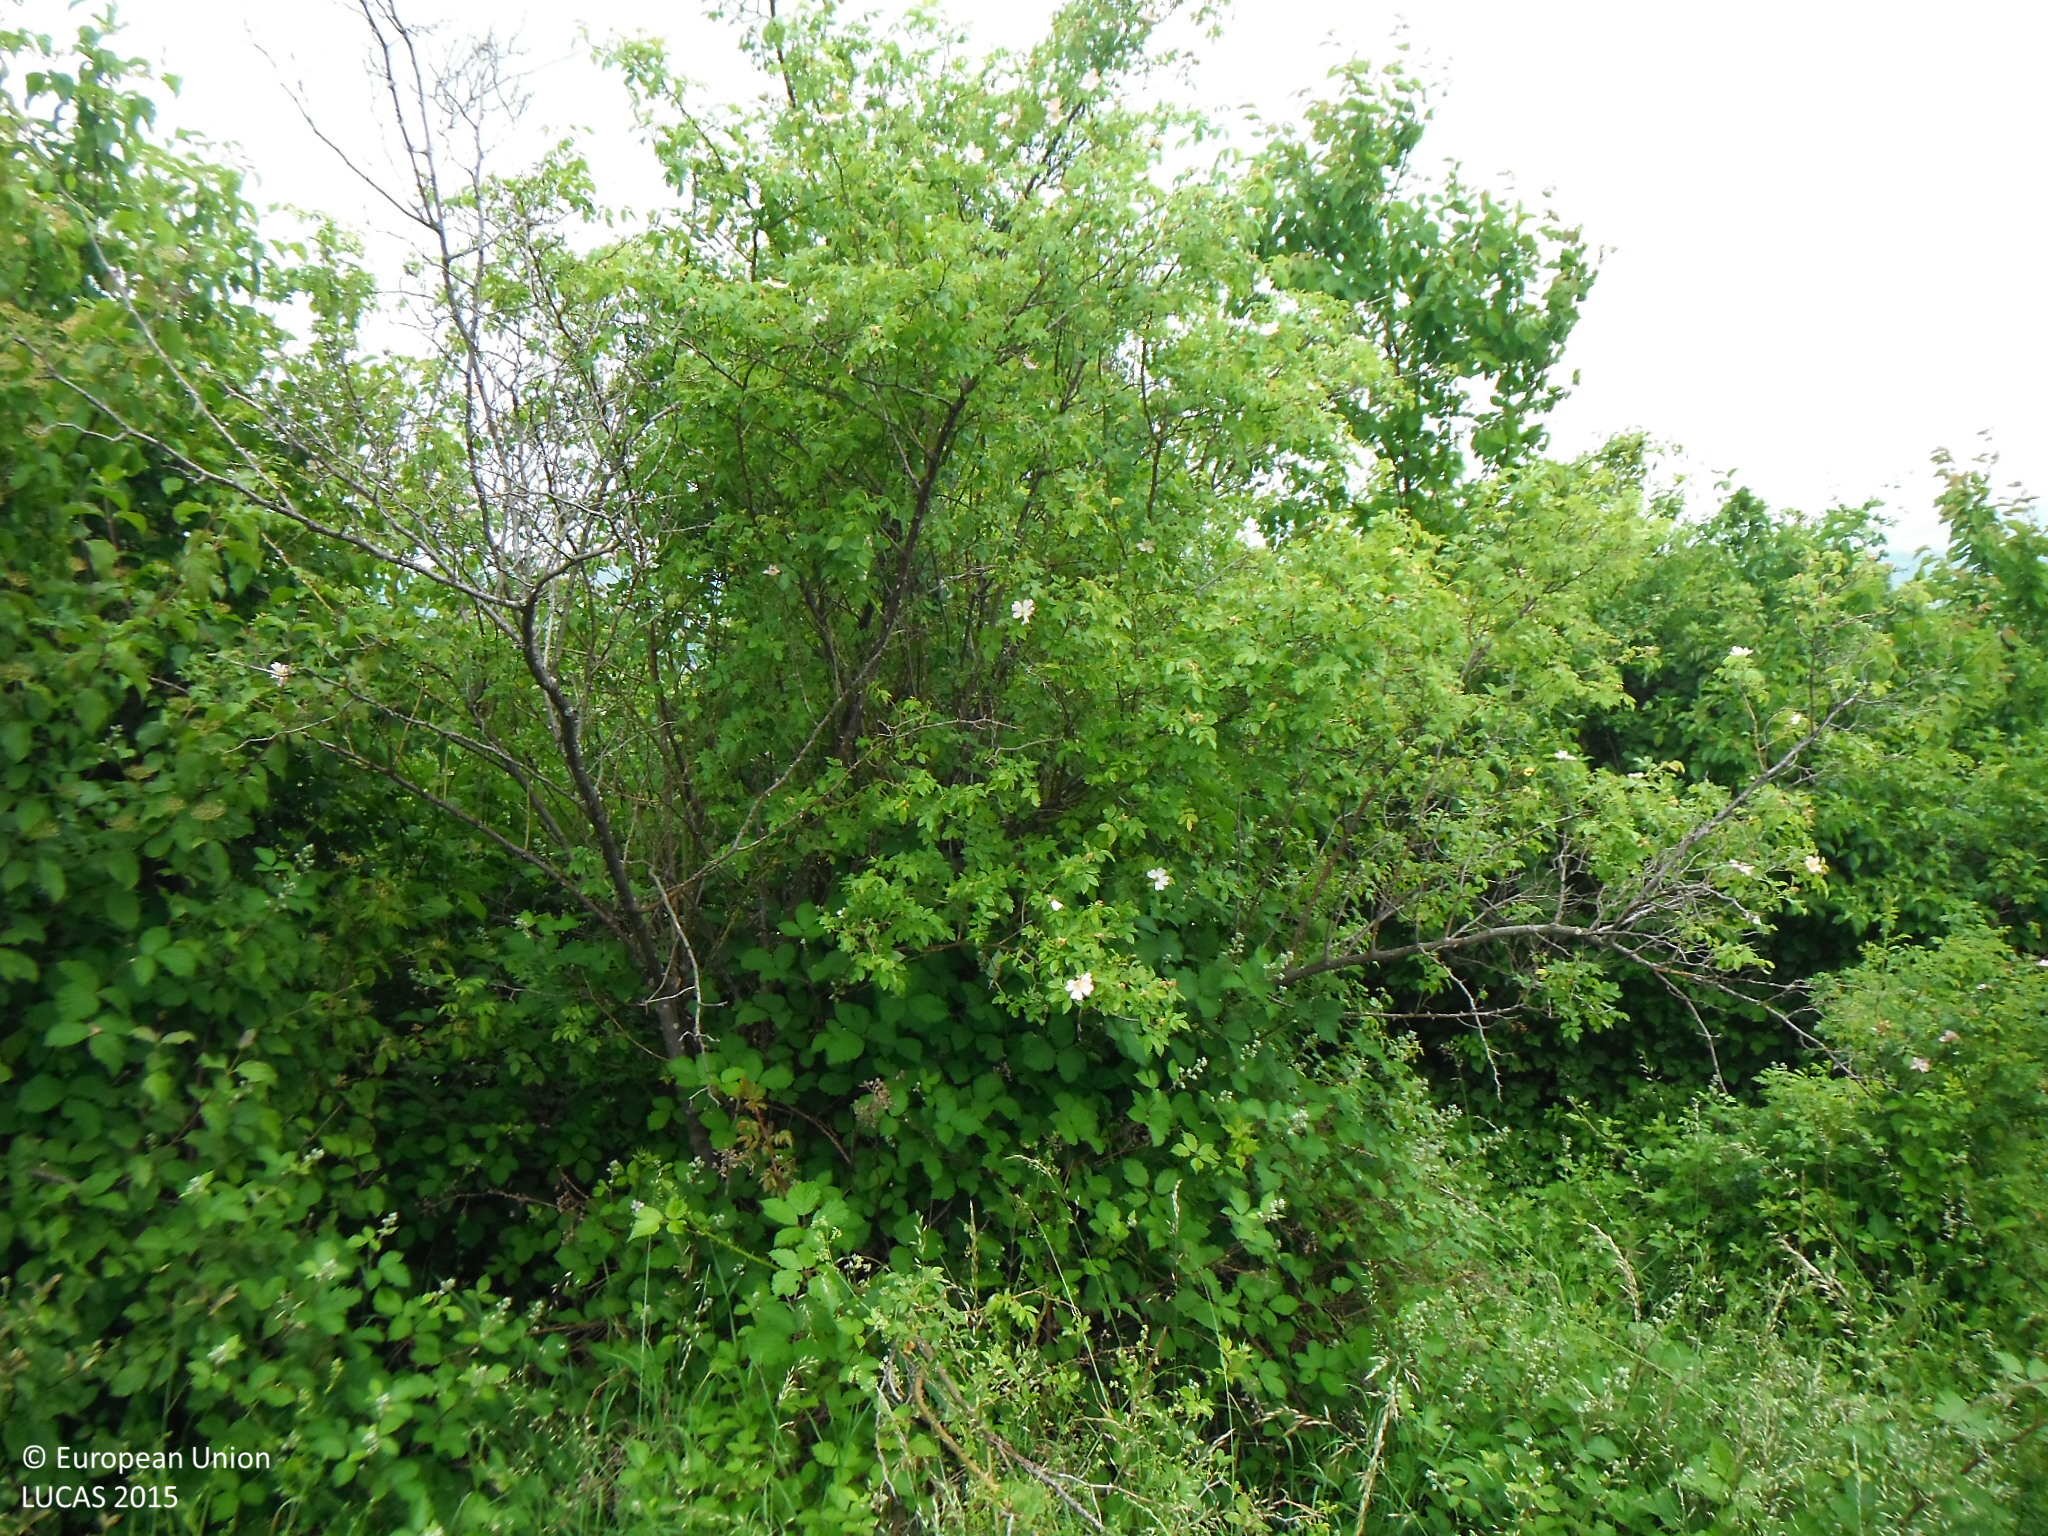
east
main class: Shrubland
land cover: Shrubland without tree cover
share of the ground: 50 - 75 %
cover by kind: shrubs 60 %, herbaceous plants 40 %
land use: Abandoned areas
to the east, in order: Shrubland without tree cover; Grassland without tree/shrub cover; Tracks; Grassland without tree/shrub cover; Grassland with sparse tree/shrub cover; Shrubland with sparse tree cover; Ditches and canals; Broadleaved woodland
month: June
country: SK
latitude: 49.1918
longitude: 21.2285
